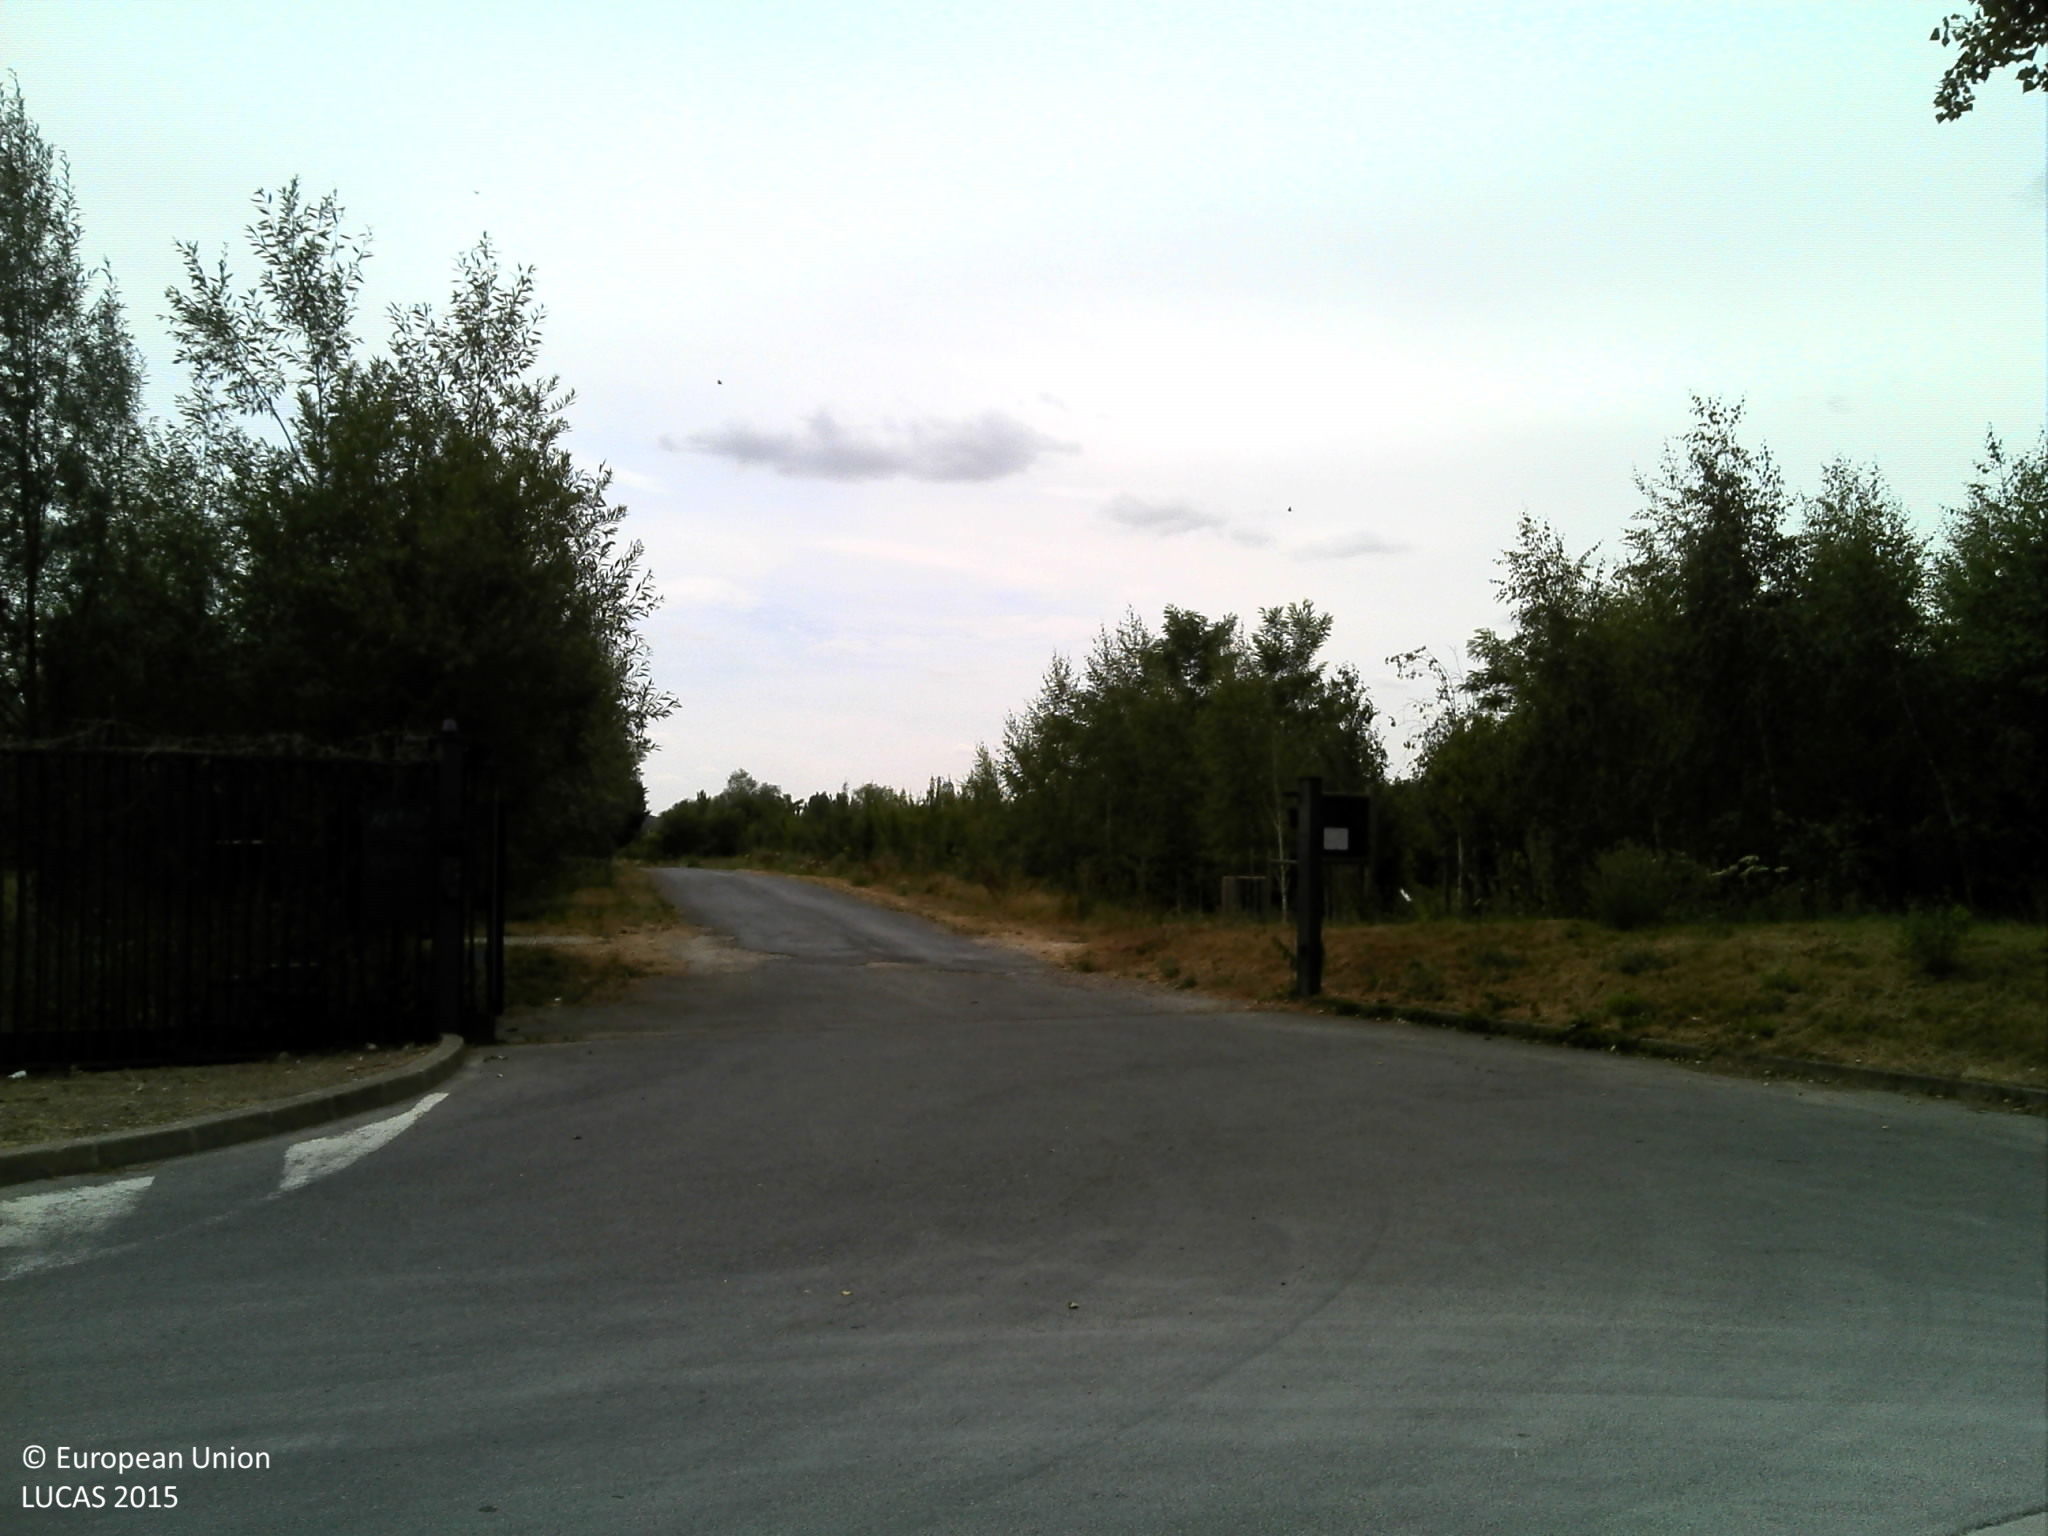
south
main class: Woodland
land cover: Broadleaved woodland
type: floodplain forest
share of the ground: > 75 %
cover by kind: broadleaved forest trees 70 %, herbaceous plants 30 %
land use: Amenities, museums, leisure
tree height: > 5 m
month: July
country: FR
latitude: 48.5996
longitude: 2.4903
